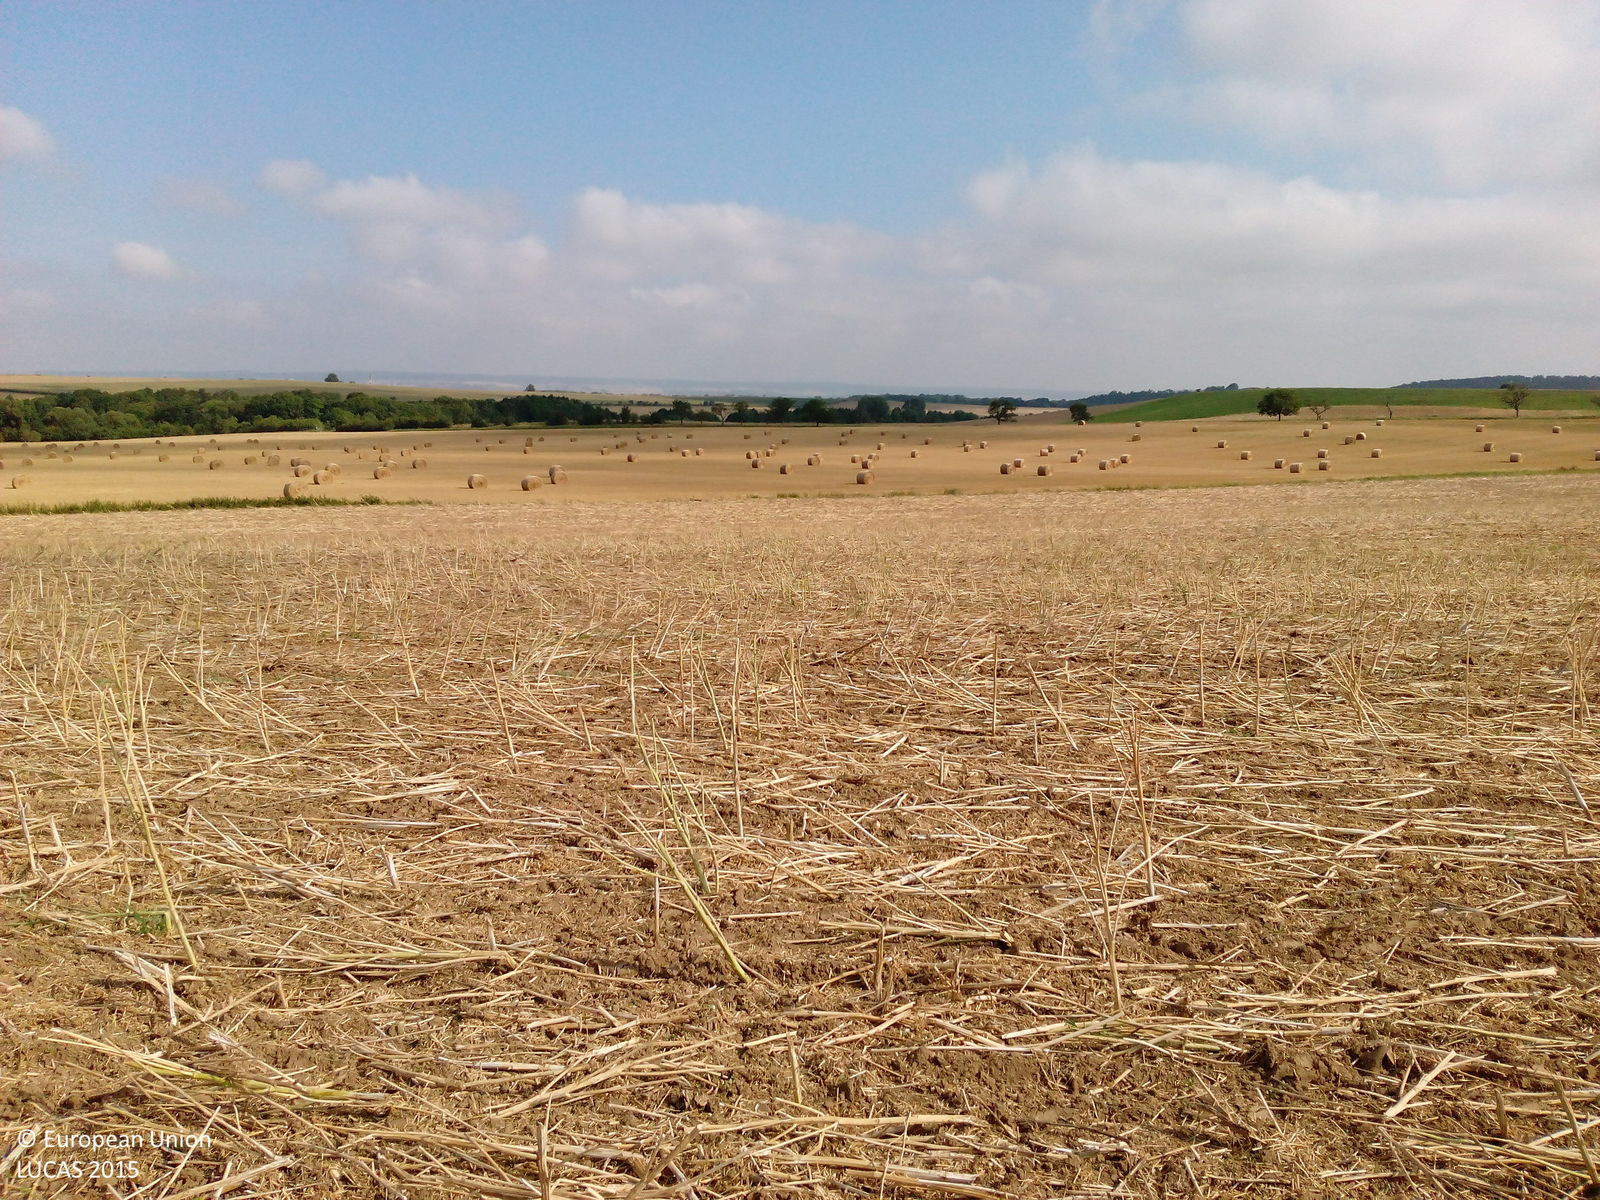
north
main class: Cropland
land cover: Rape and turnip rape
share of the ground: 10 - 25 %
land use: Agriculture (excluding fallow land and kitchen gardens)
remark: Harvested field
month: August
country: DE
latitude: 51.8342
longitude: 10.9720
